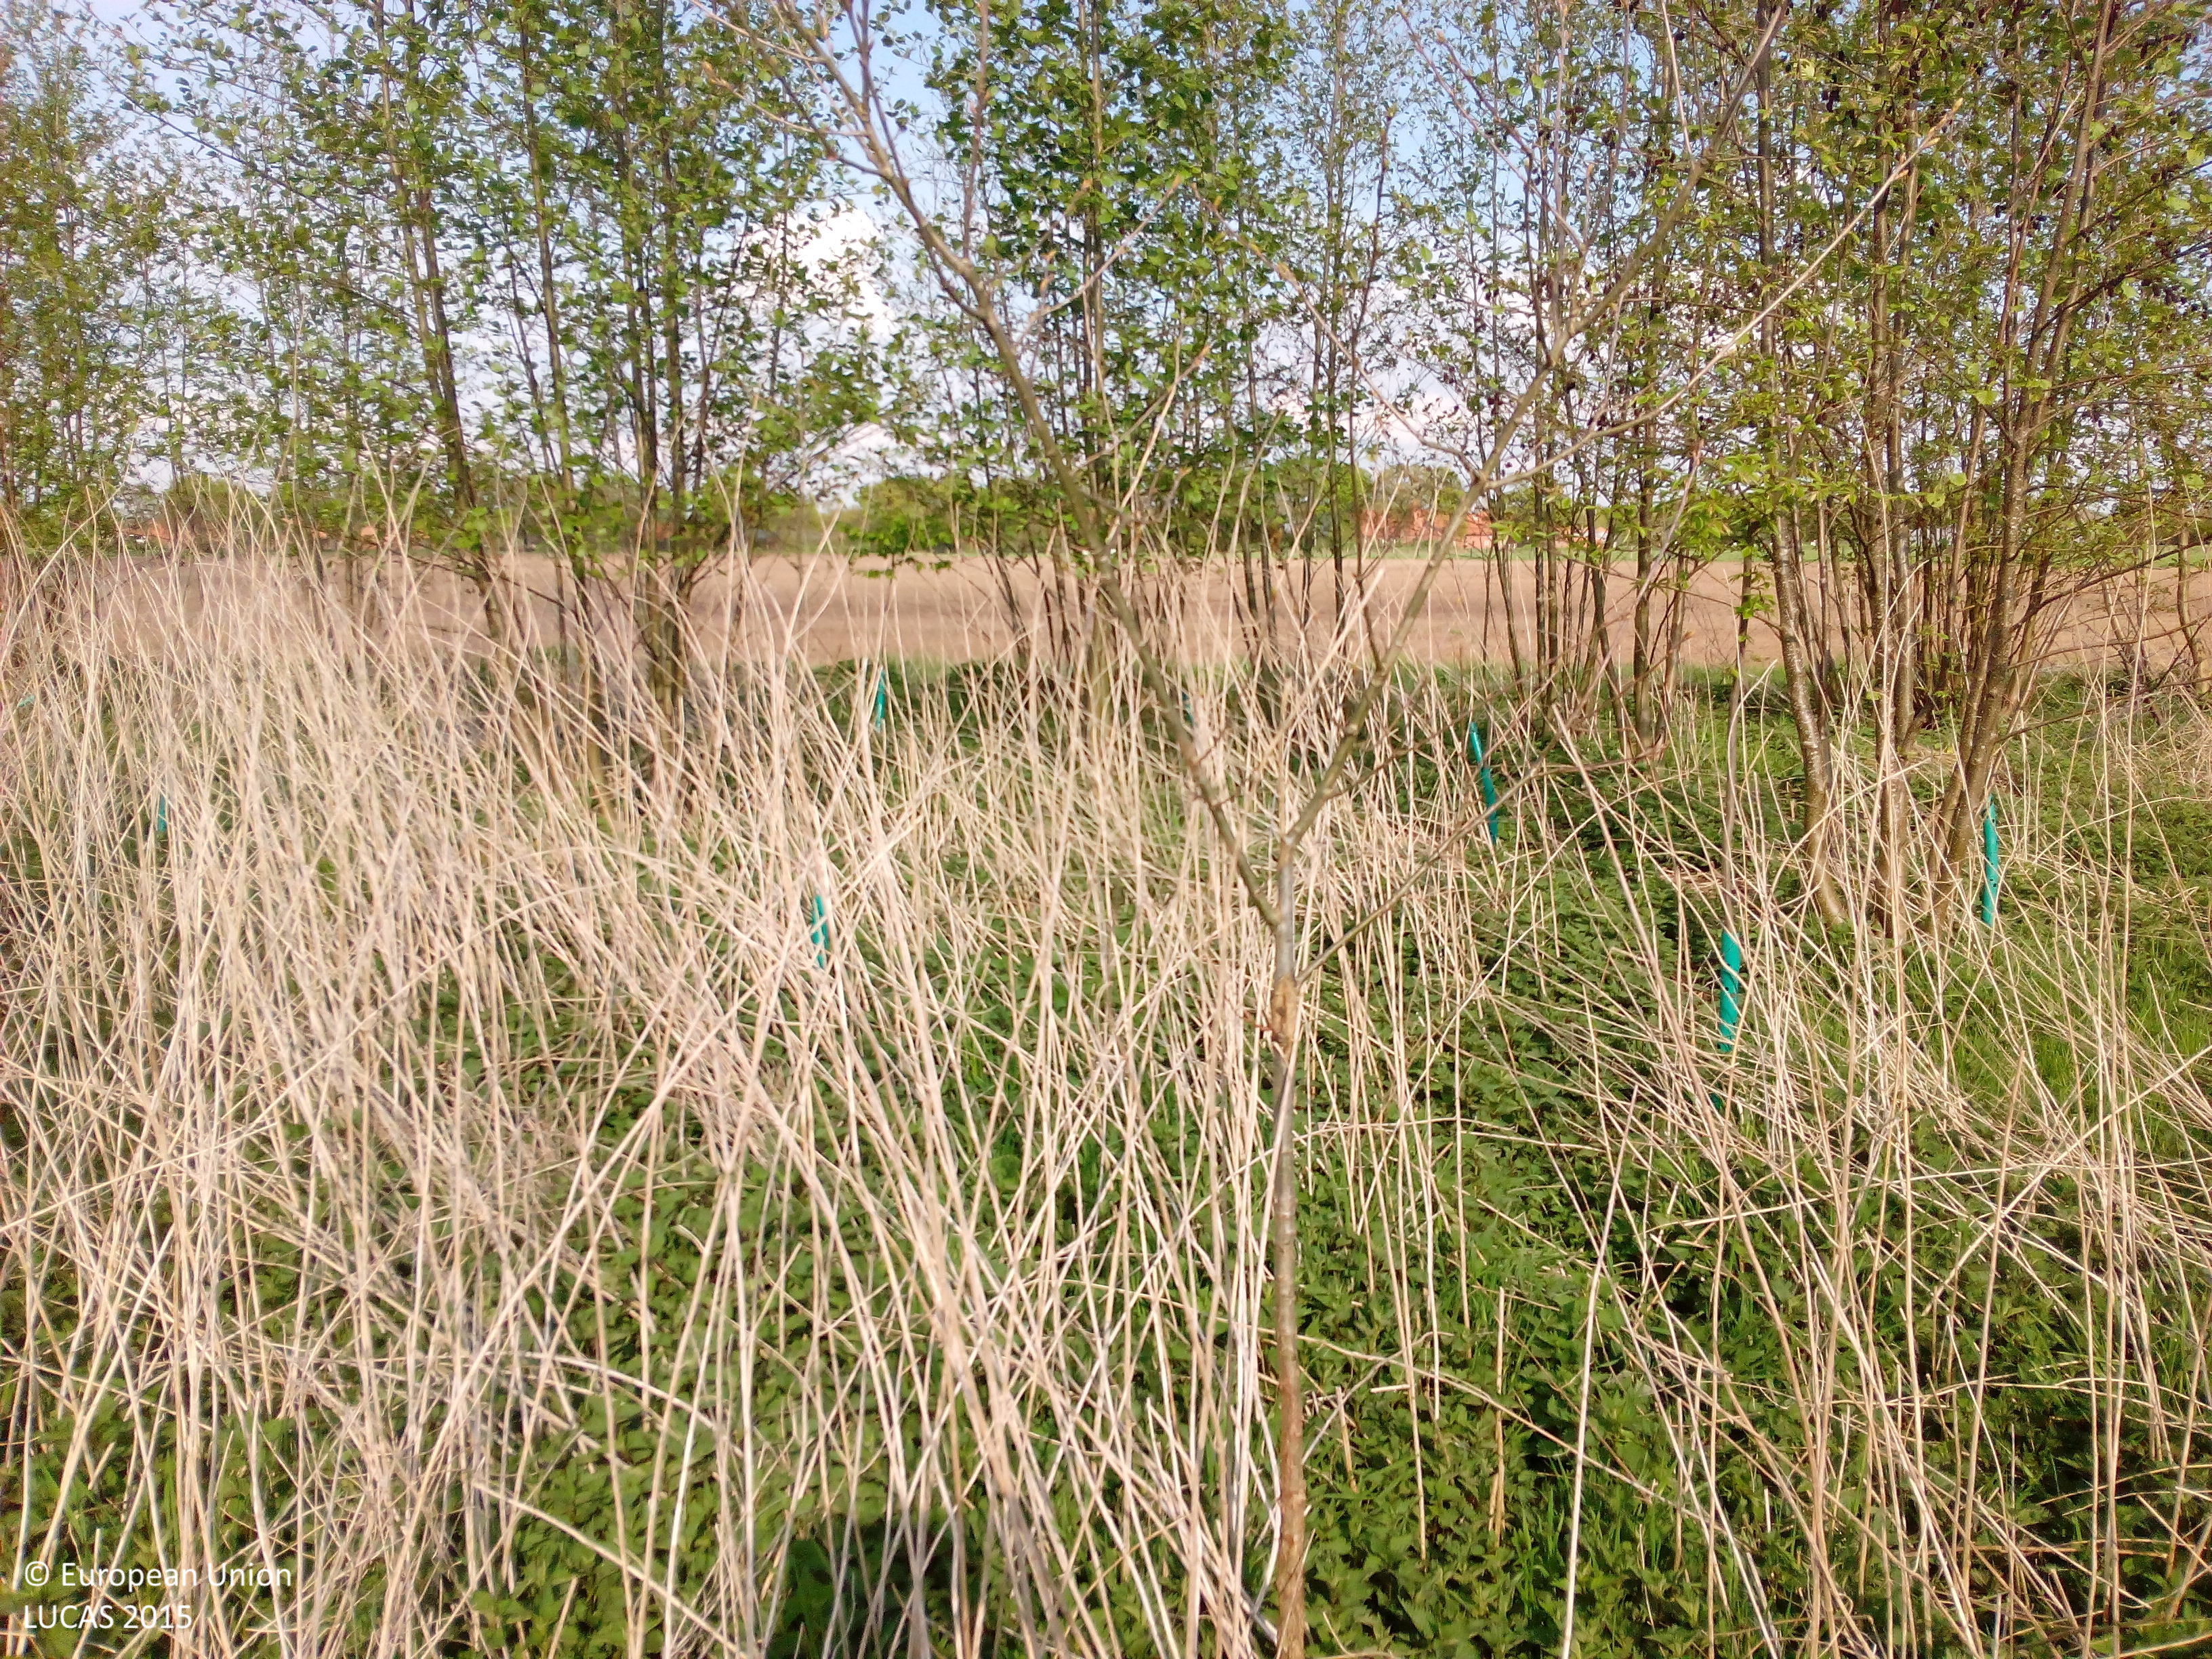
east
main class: Woodland
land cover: Broadleaved woodland
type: mesophytic deciduous forest
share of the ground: 10 - 25 %
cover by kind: herbaceous plants 80 %, broadleaved forest trees 20 %
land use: Forestry
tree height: > 5 m
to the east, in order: Broadleaved woodland; Grassland without tree/shrub cover; Ditches and canals; Grass margins; Maize; Fences; Grassland without tree/shrub cover
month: May
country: DE
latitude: 52.1521
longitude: 7.4426
